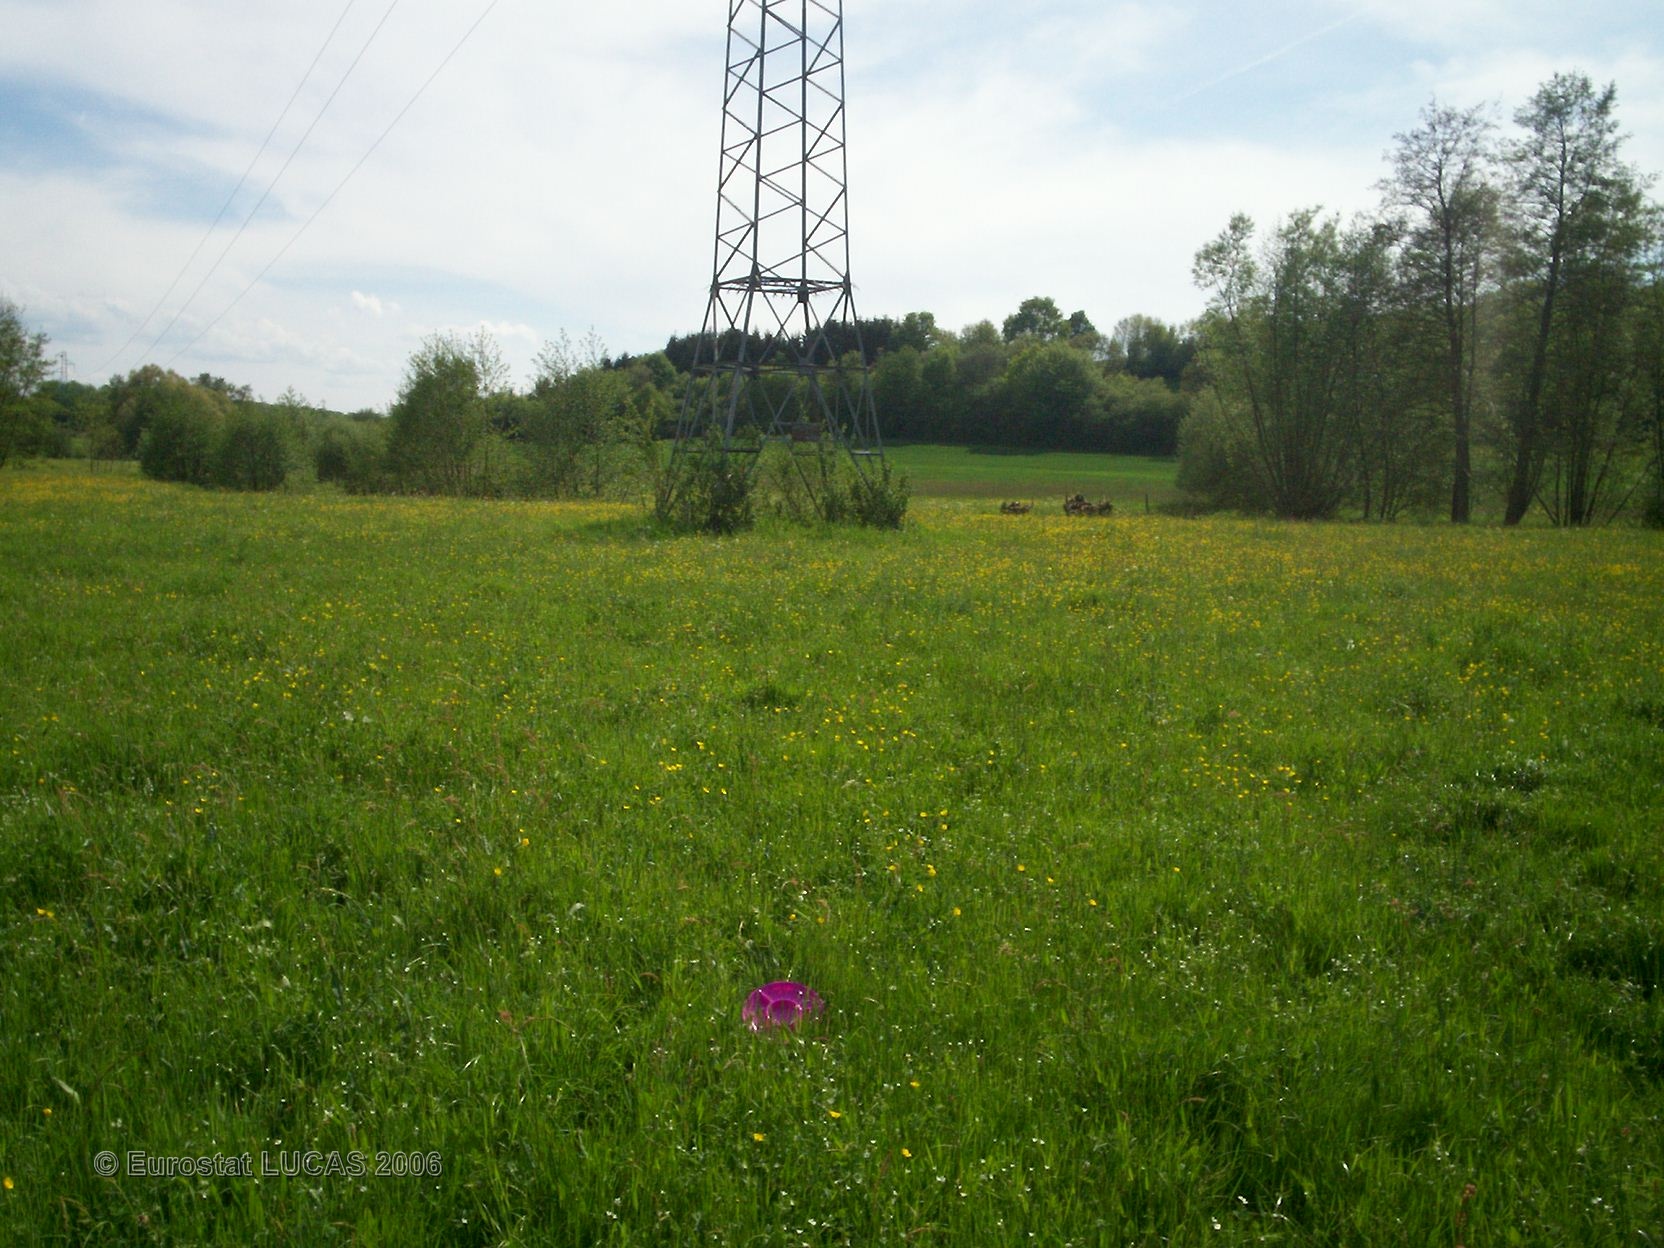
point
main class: Grassland
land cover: Grassland without tree/shrub cover
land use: Agriculture (excluding fallow land and kitchen gardens)
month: May
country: FR
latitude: 48.8328
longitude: 7.0716
